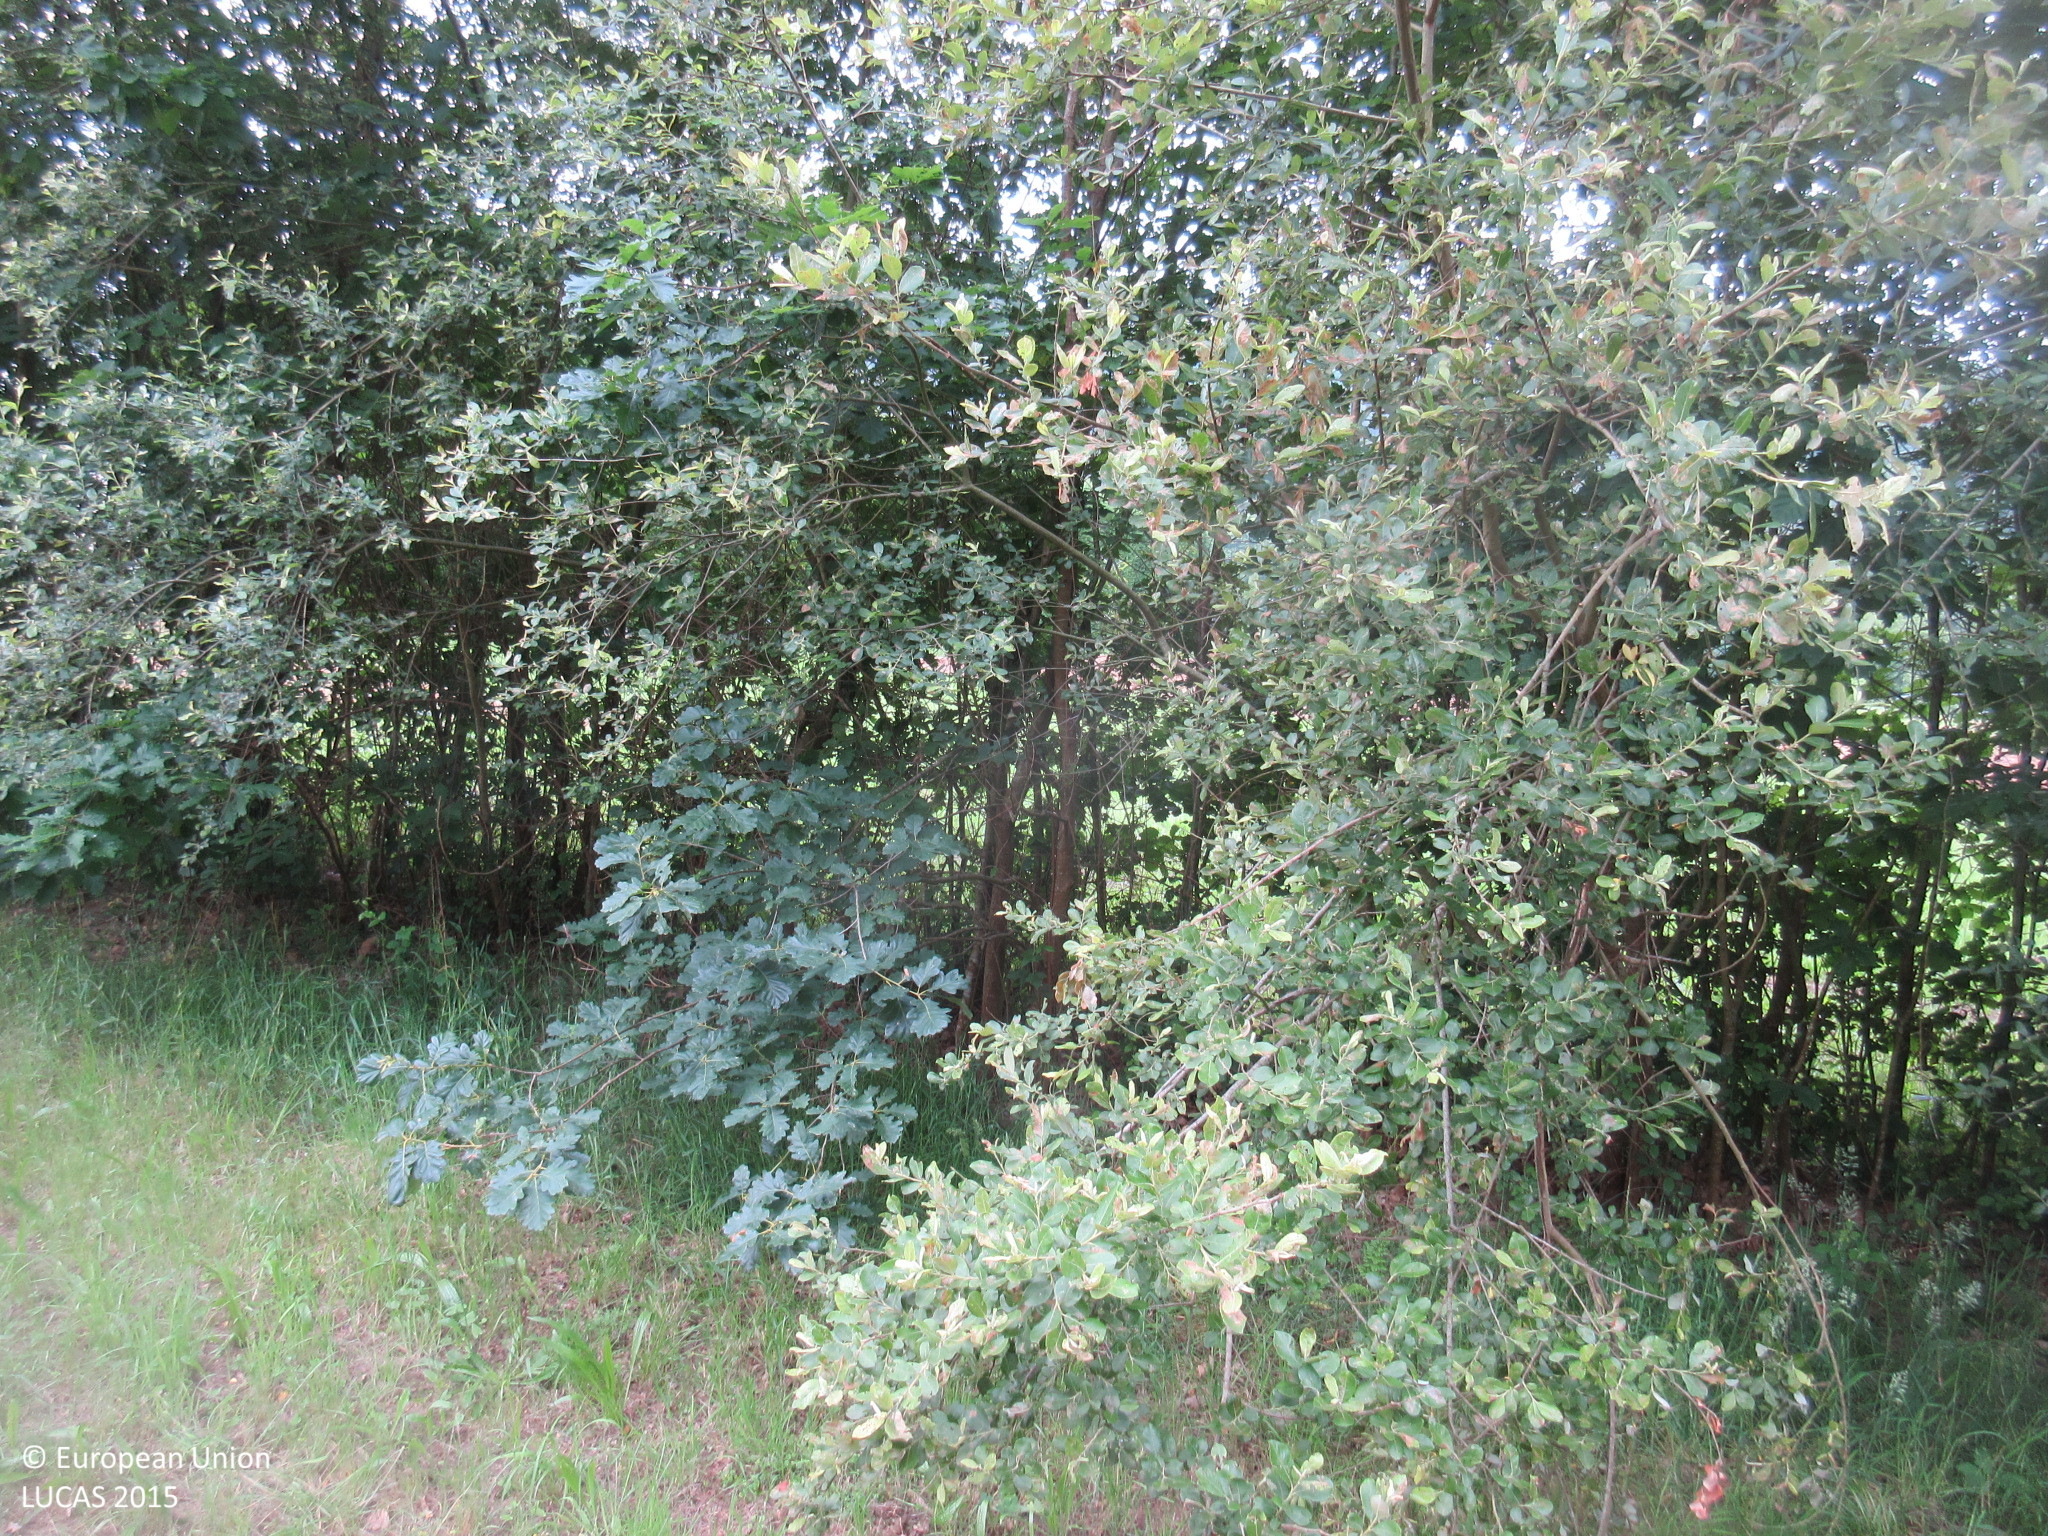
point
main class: Grassland
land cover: Grassland without tree/shrub cover
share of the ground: > 75 %
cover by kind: herbaceous plants 100 %
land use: Agriculture (excluding fallow land and kitchen gardens)
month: June
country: ES
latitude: 43.3594
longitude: -4.1323
